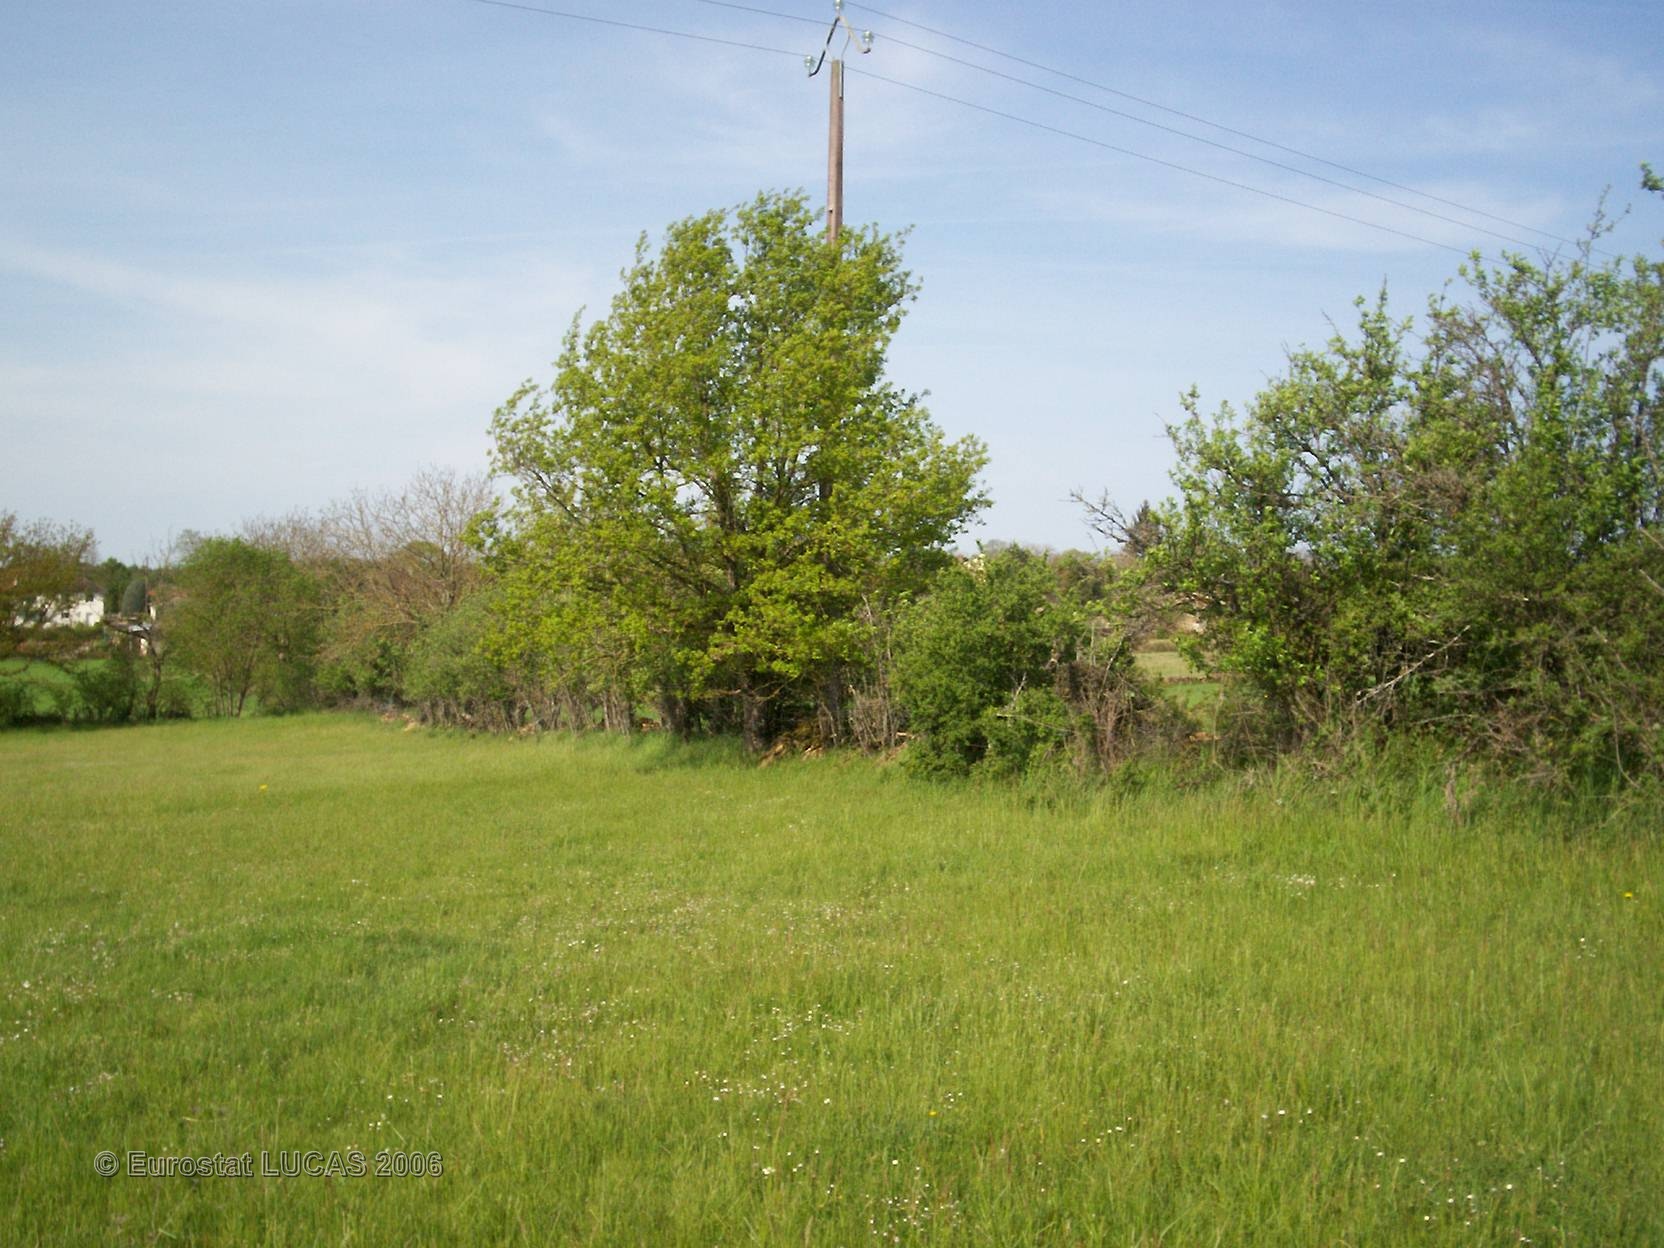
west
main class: Grassland
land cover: Grassland without tree/shrub cover
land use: Agriculture (excluding fallow land and kitchen gardens)
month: May
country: FR
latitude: 44.7504
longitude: 1.8009
